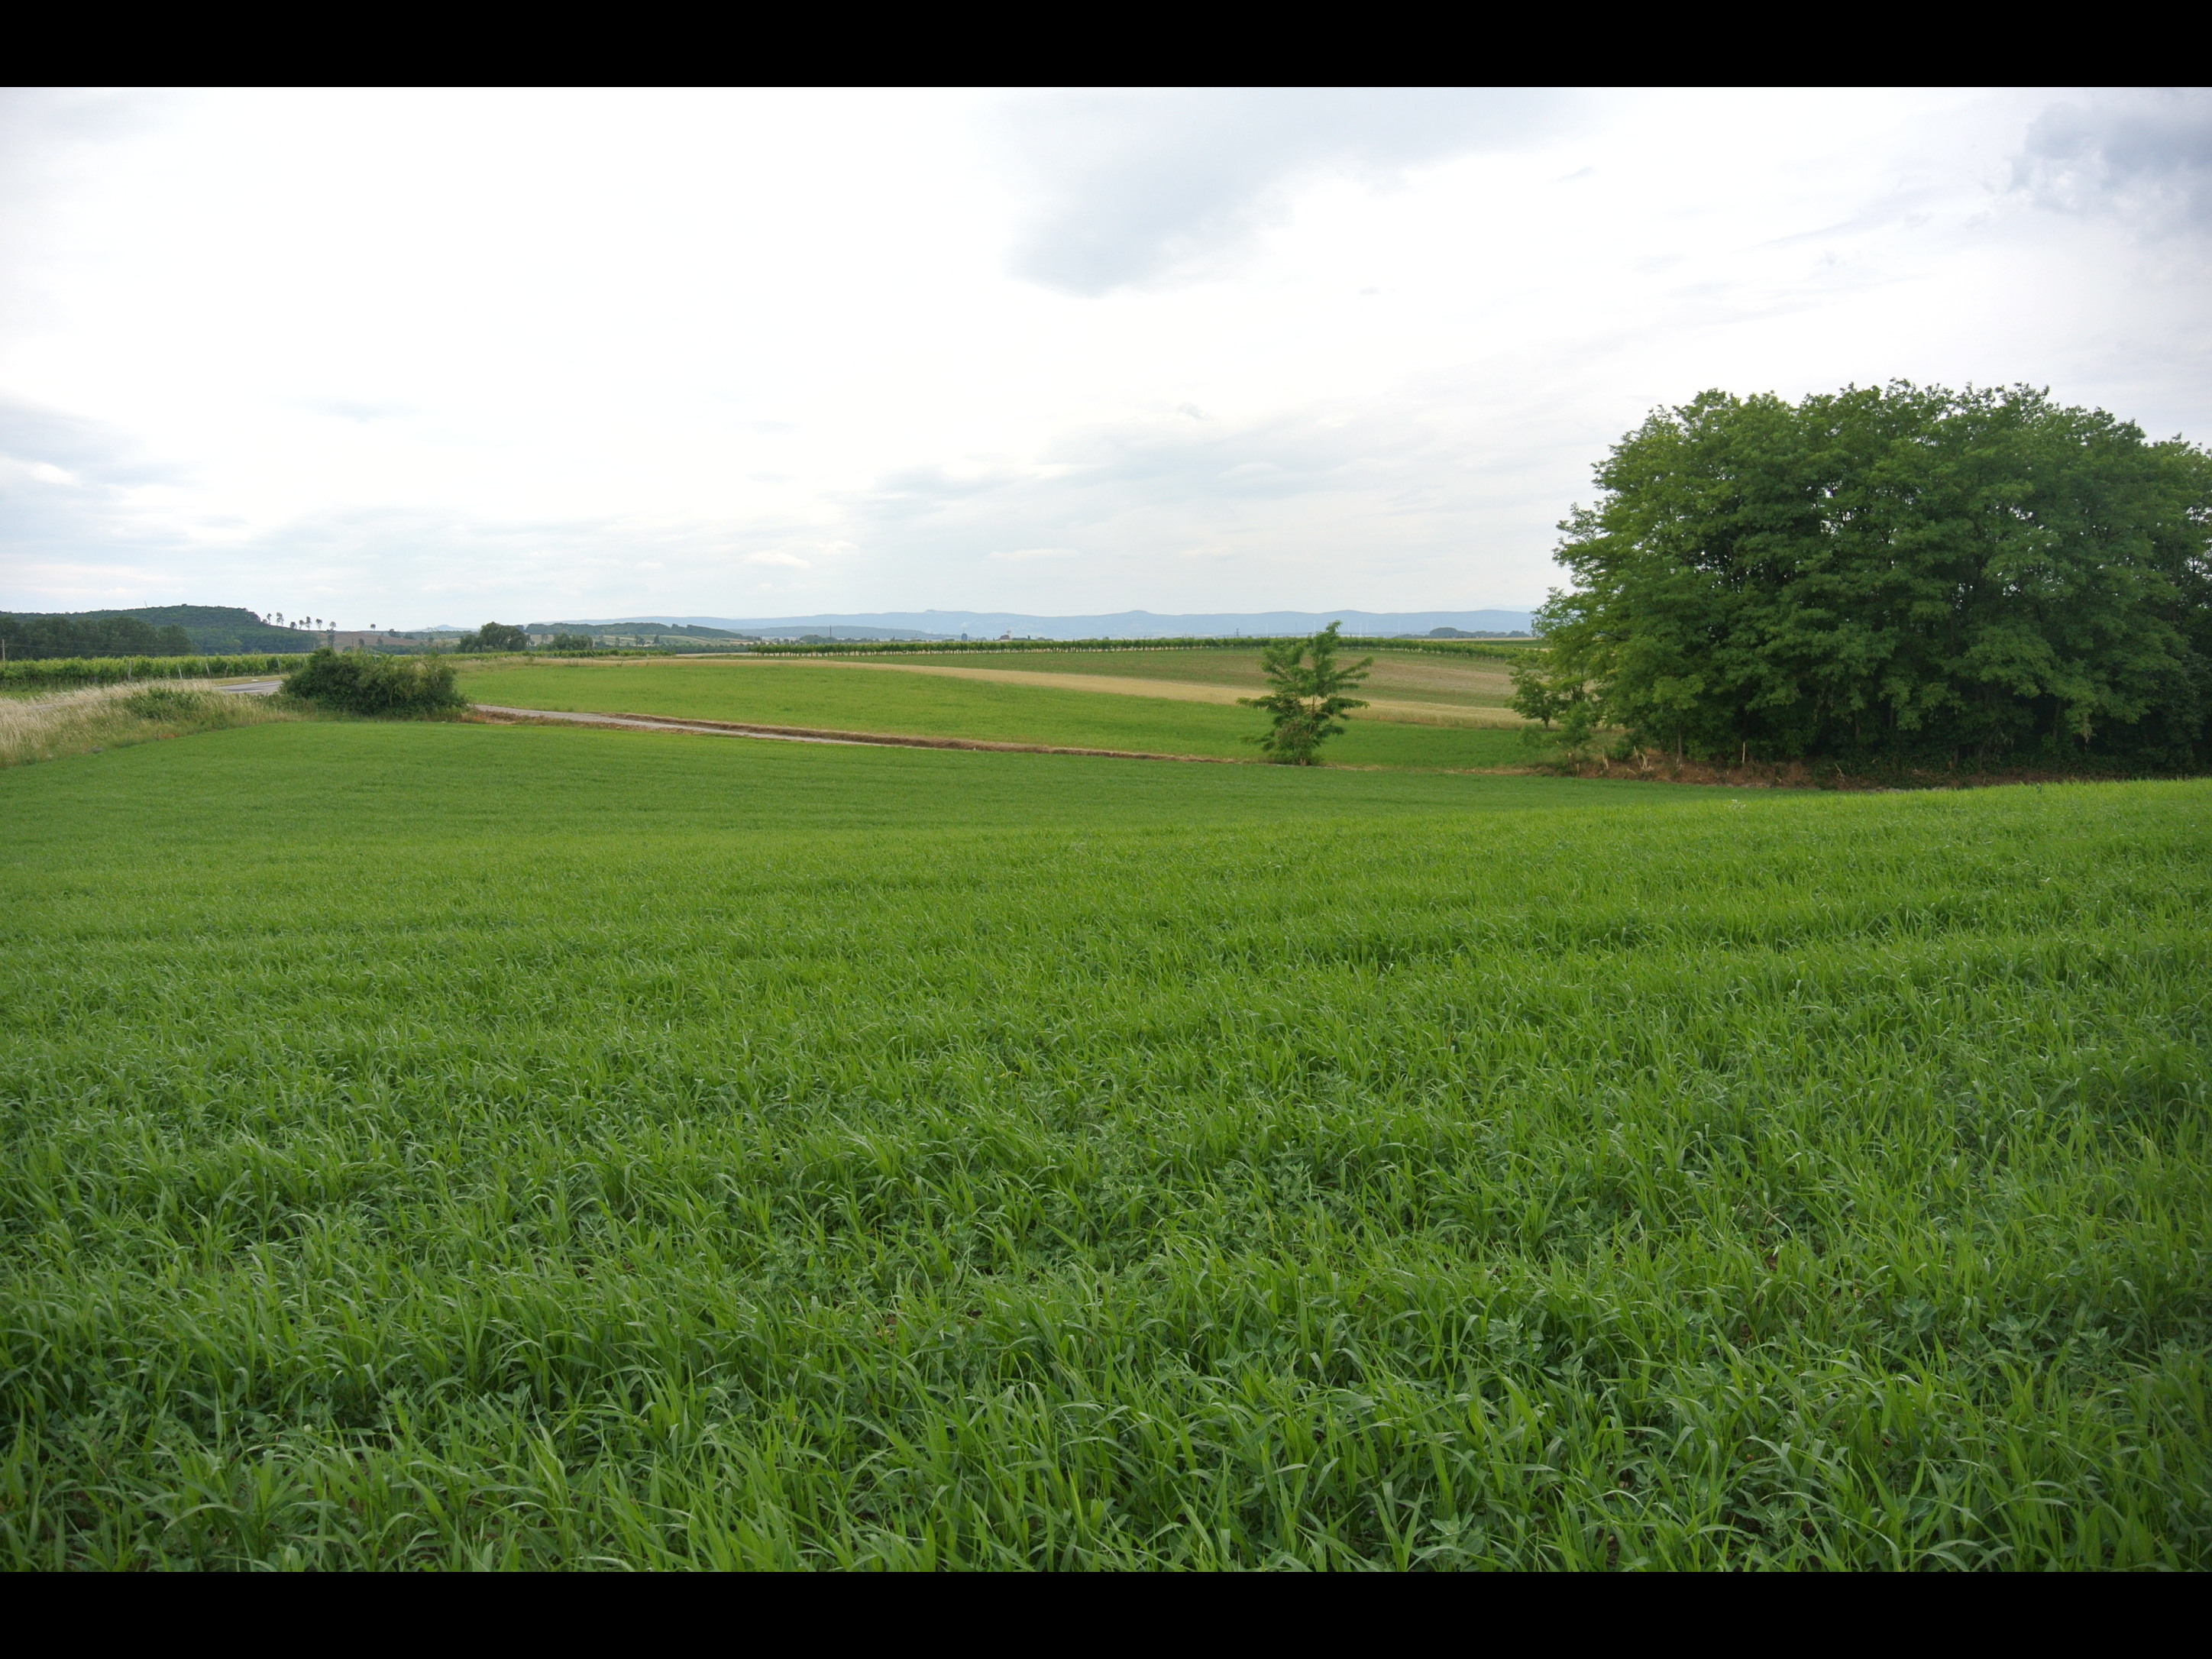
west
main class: Cropland
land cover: Common wheat
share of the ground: > 75 %
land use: Agriculture (excluding fallow land and kitchen gardens)
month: June
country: AT
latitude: 47.7918
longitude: 16.5860
